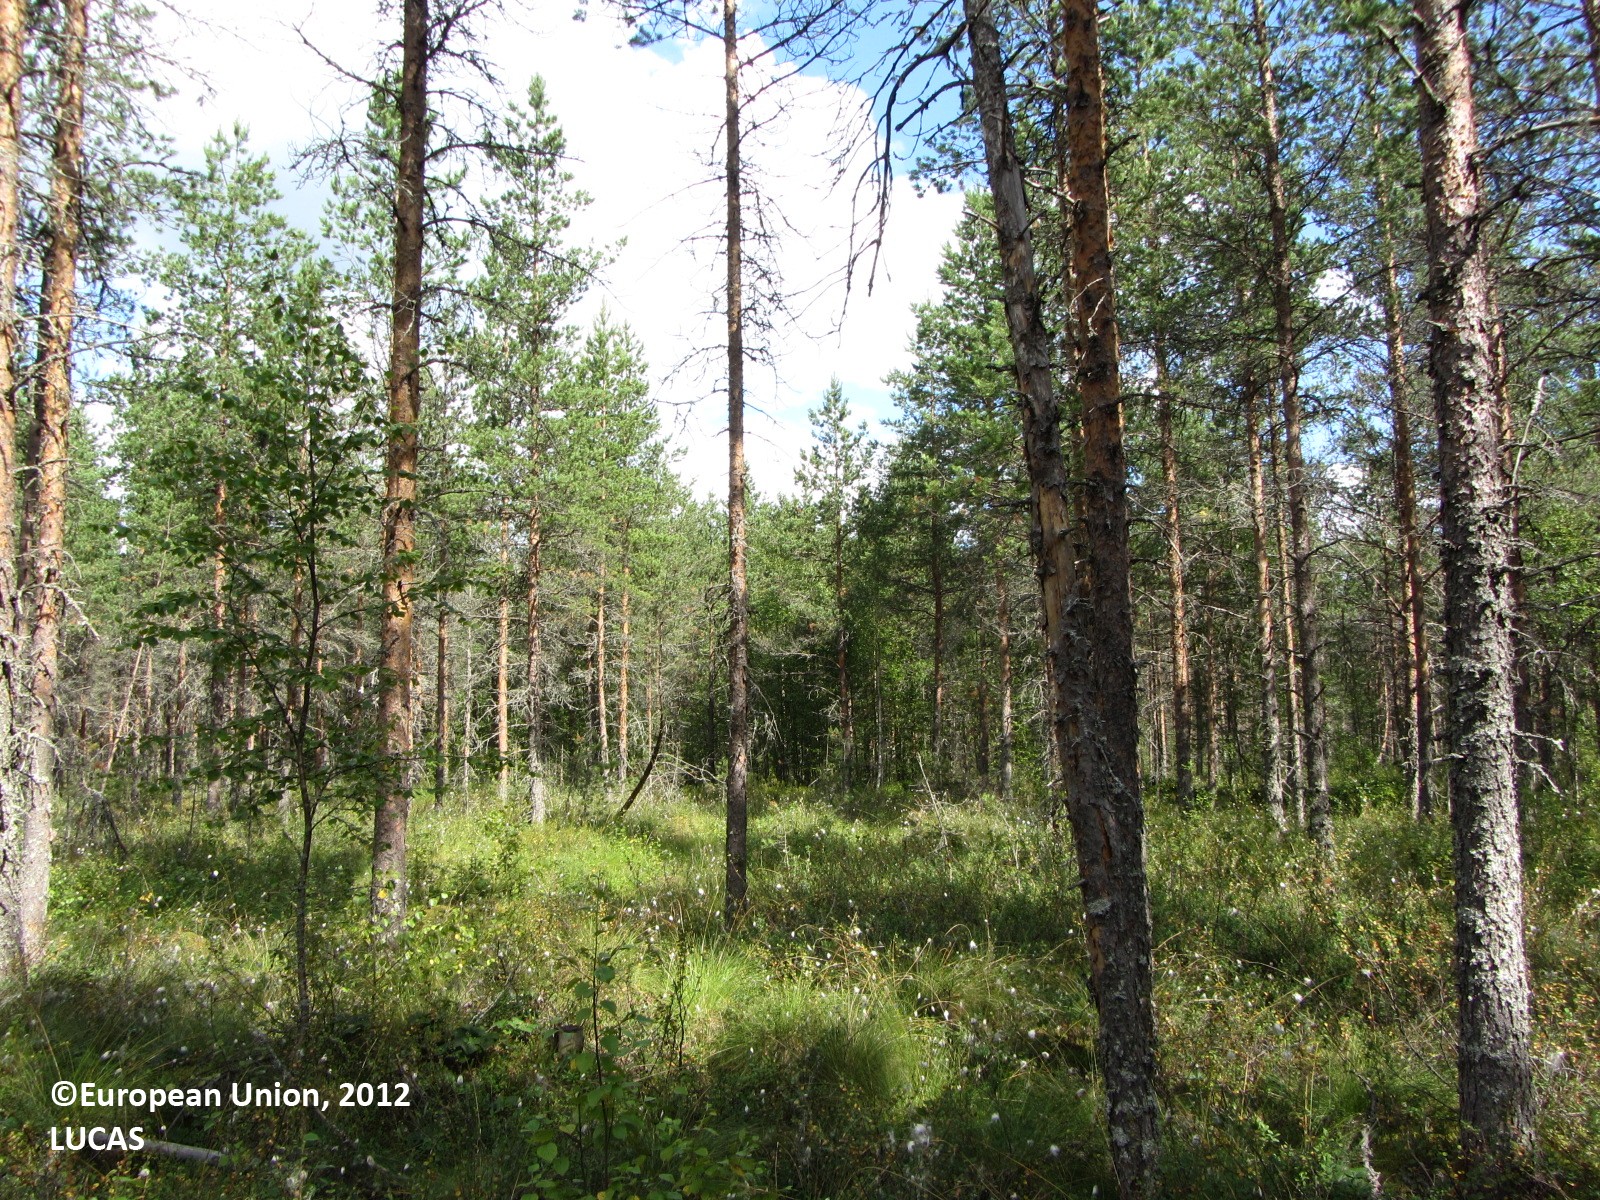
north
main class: Woodland
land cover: Pine dominated mixed woodland
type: boreal forest
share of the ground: 50 - 75 %
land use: Forestry
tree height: > 5 m
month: July
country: FI
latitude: 63.6445
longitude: 24.5968
